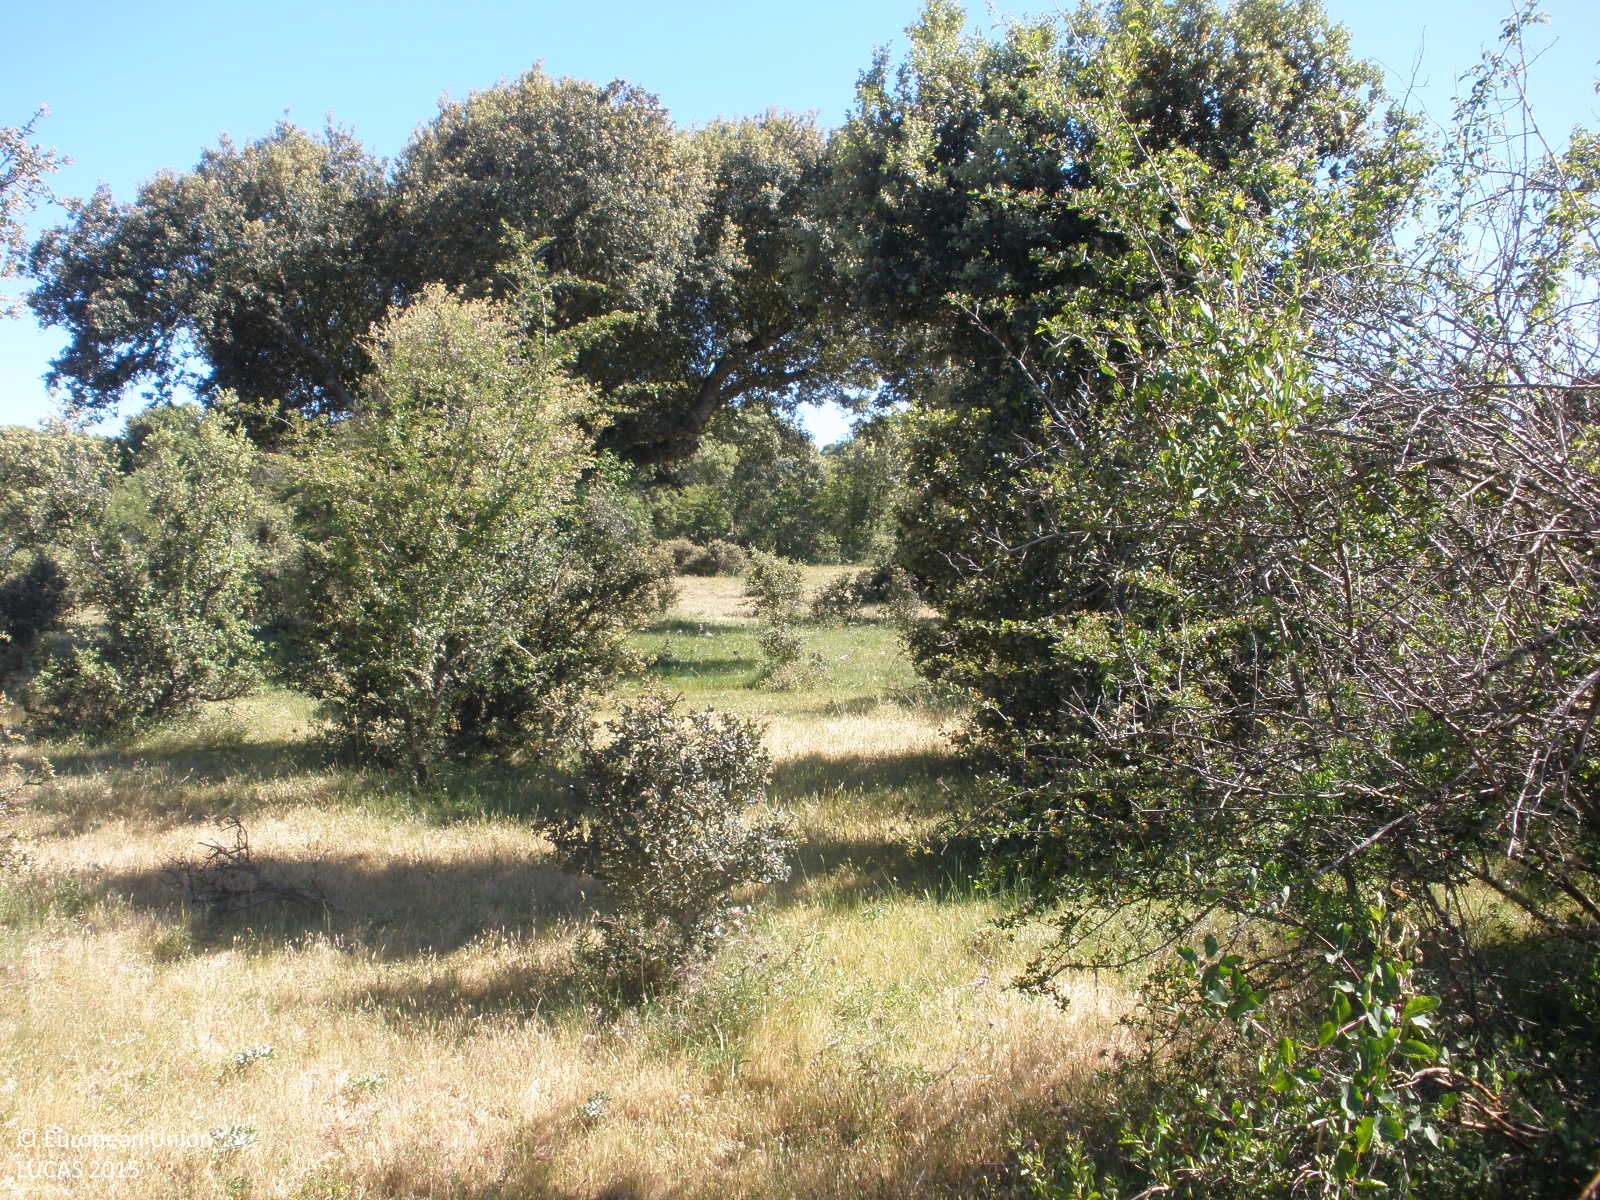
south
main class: Woodland
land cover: Broadleaved woodland
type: broadleaved evergreen forest
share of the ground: 25 - 50 %
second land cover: Grassland without tree/shrub cover
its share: > 75 %
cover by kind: herbaceous plants 50 %, broadleaved forest trees 30 %, shrubs 20 %
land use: Forestry
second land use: Agriculture (excluding fallow land and kitchen gardens)
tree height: < 5 m
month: May
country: ES
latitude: 40.7333
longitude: -5.8617
